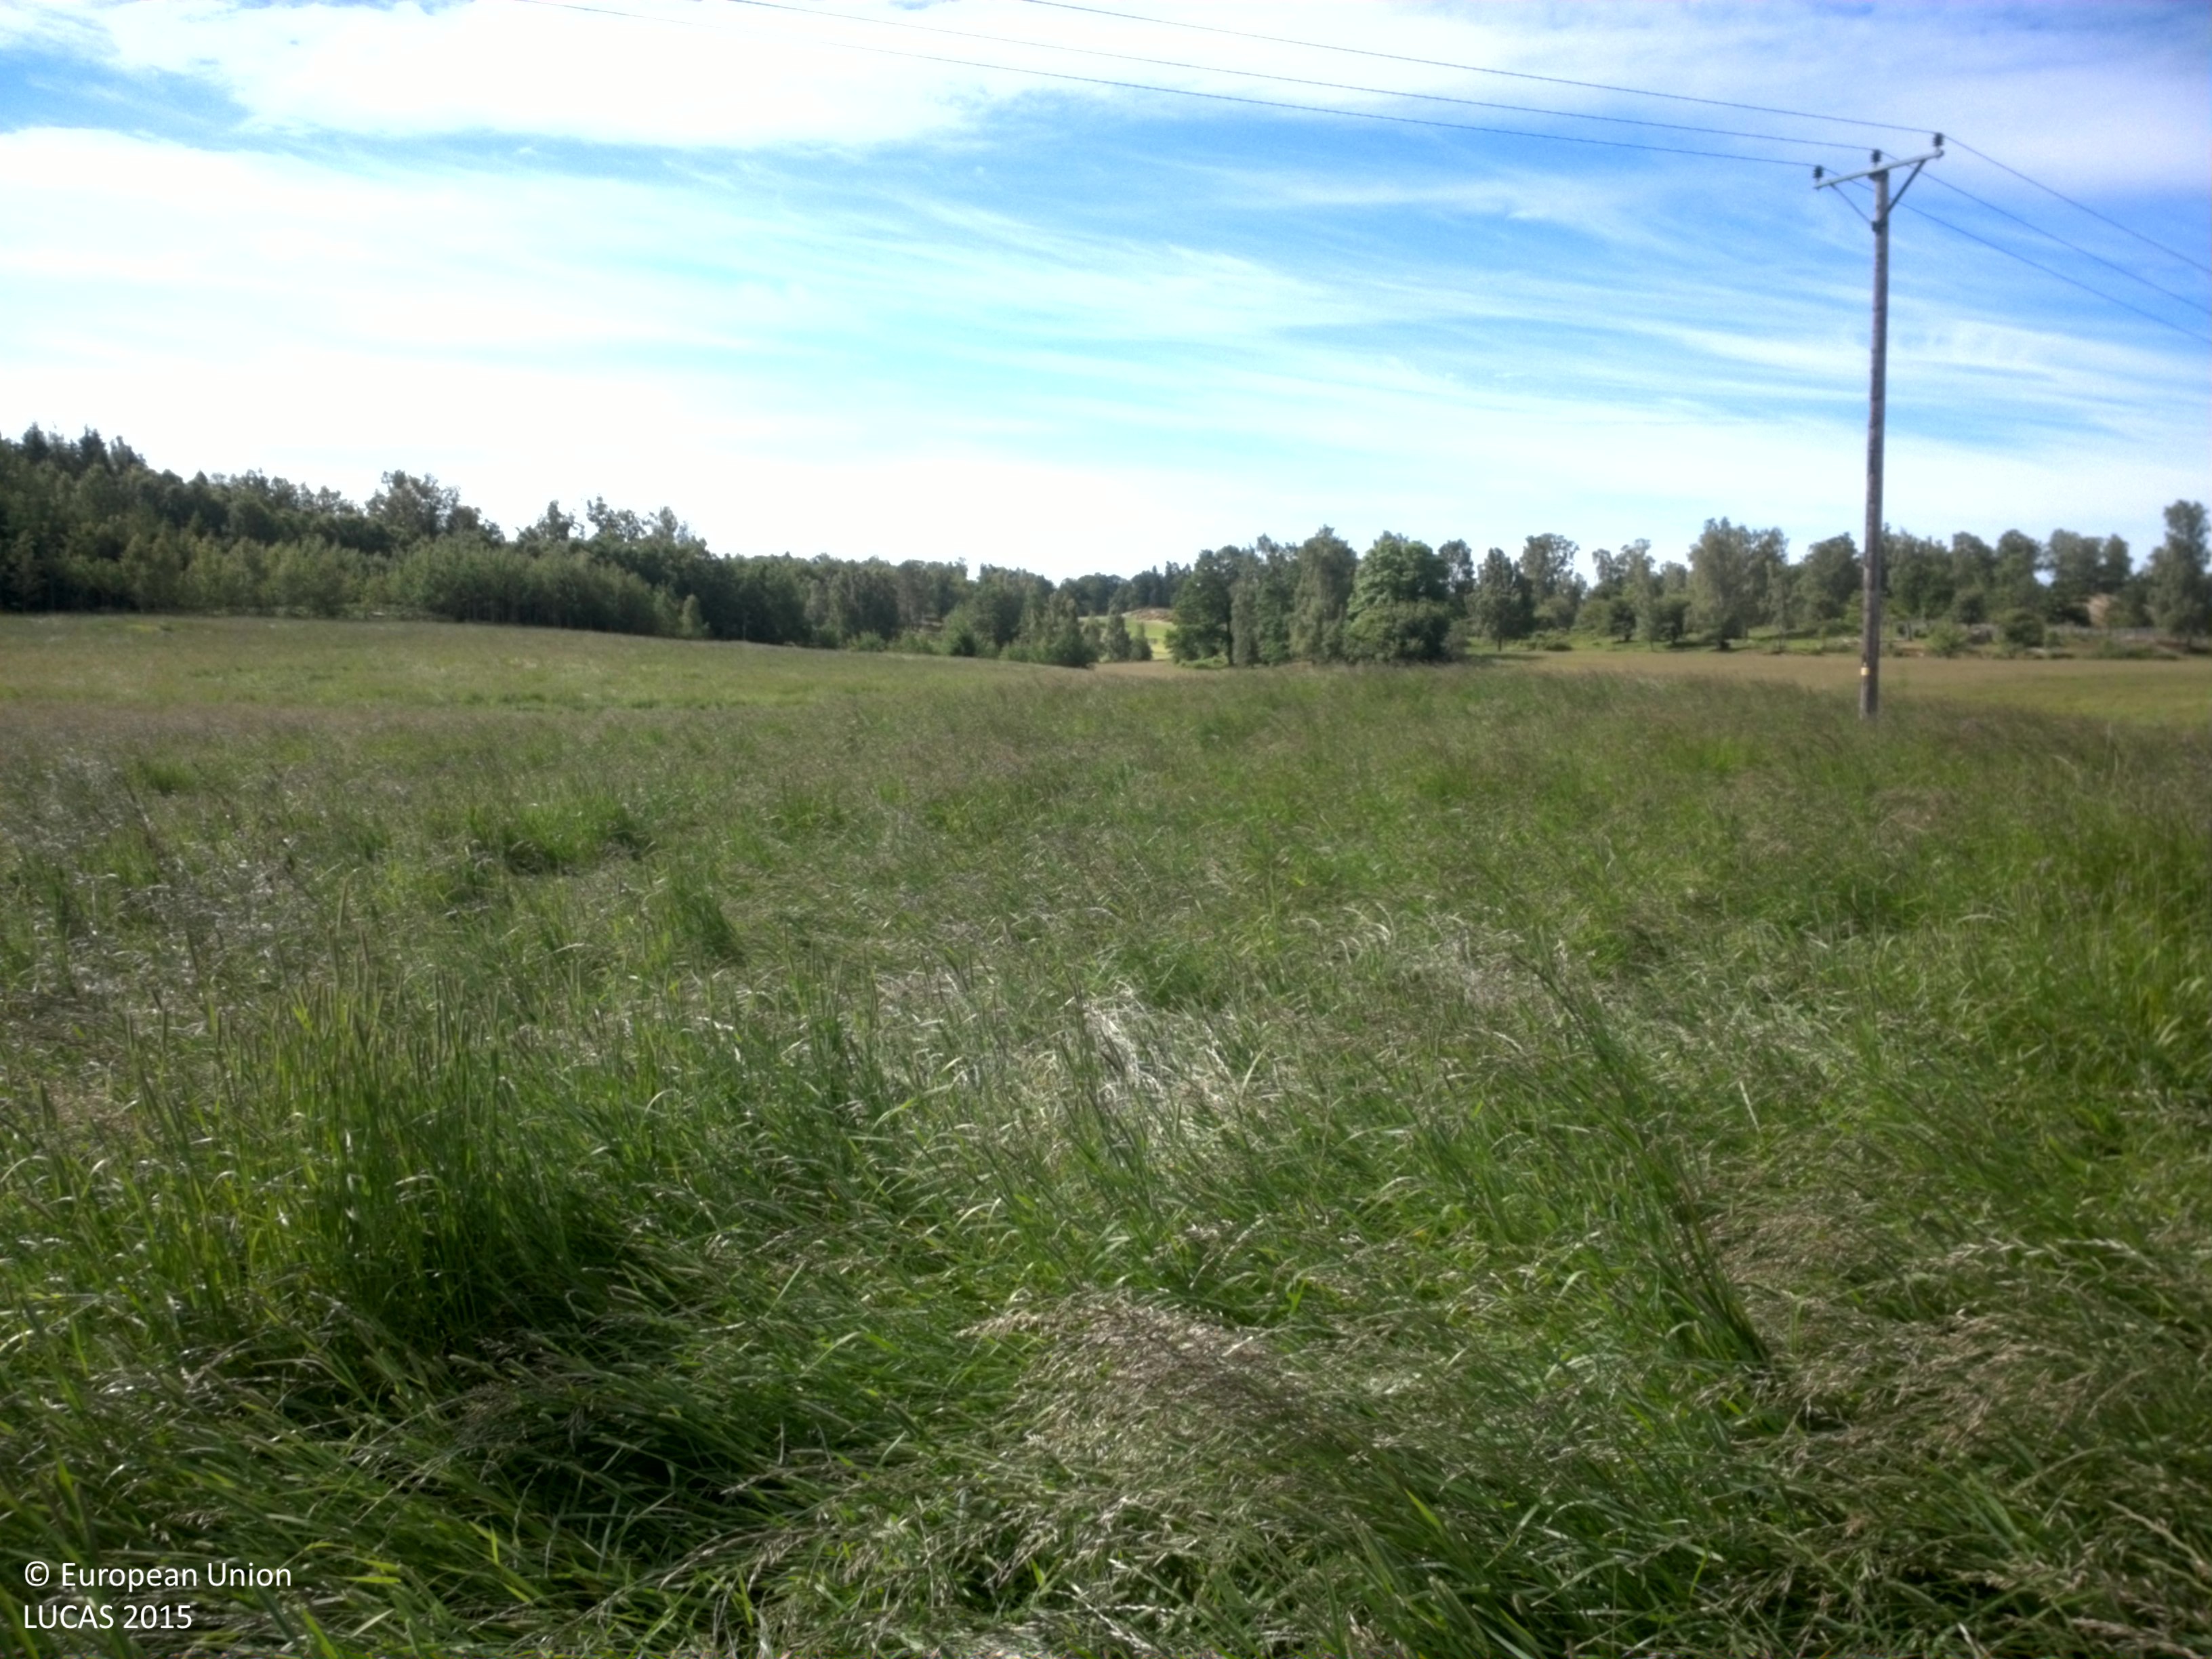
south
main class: Cropland
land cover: Temporary grasslands
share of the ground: > 75 %
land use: Agriculture (excluding fallow land and kitchen gardens)
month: June
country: SE
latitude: 58.5395
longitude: 15.5084
